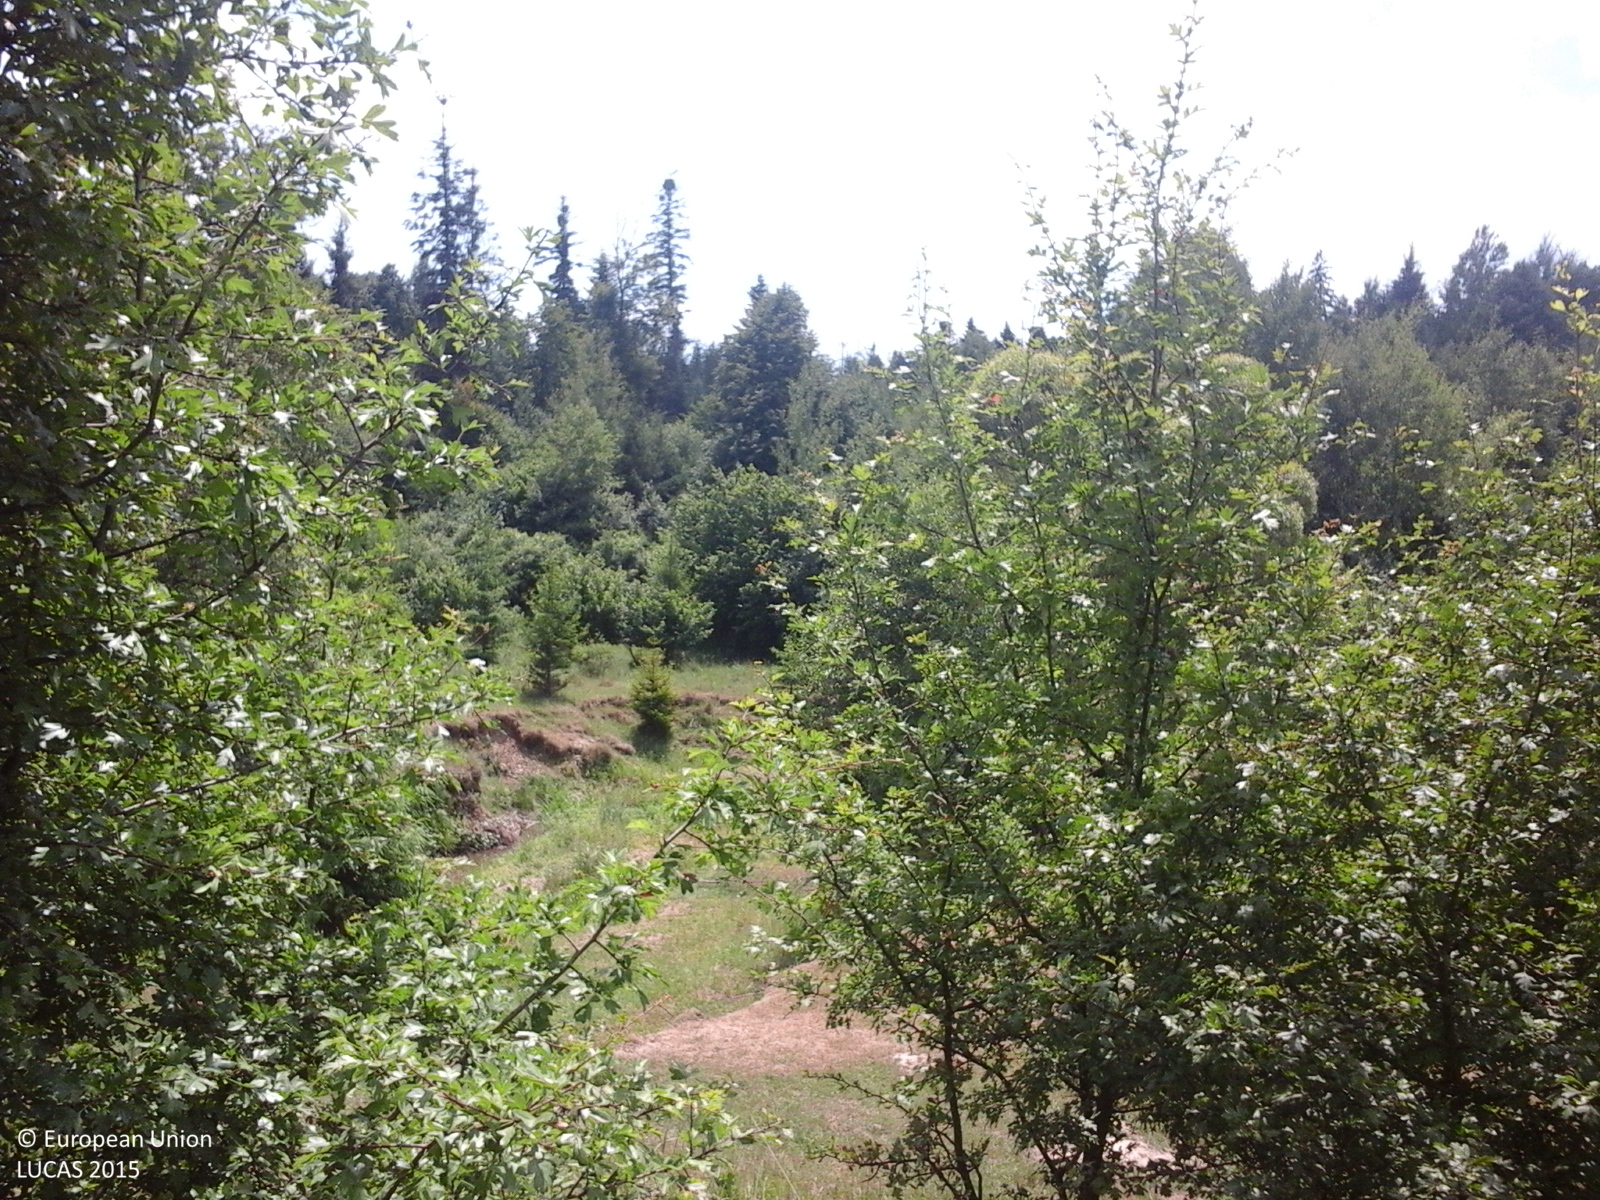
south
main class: Grassland
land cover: Grassland with sparse tree/shrub cover
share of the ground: > 75 %
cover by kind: herbaceous plants 85 %, shrubs 10 %, broadleaved forest trees 5 %
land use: Agriculture (excluding fallow land and kitchen gardens)
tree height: > 5 m
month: June
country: RO
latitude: 47.7805
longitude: 25.8623
